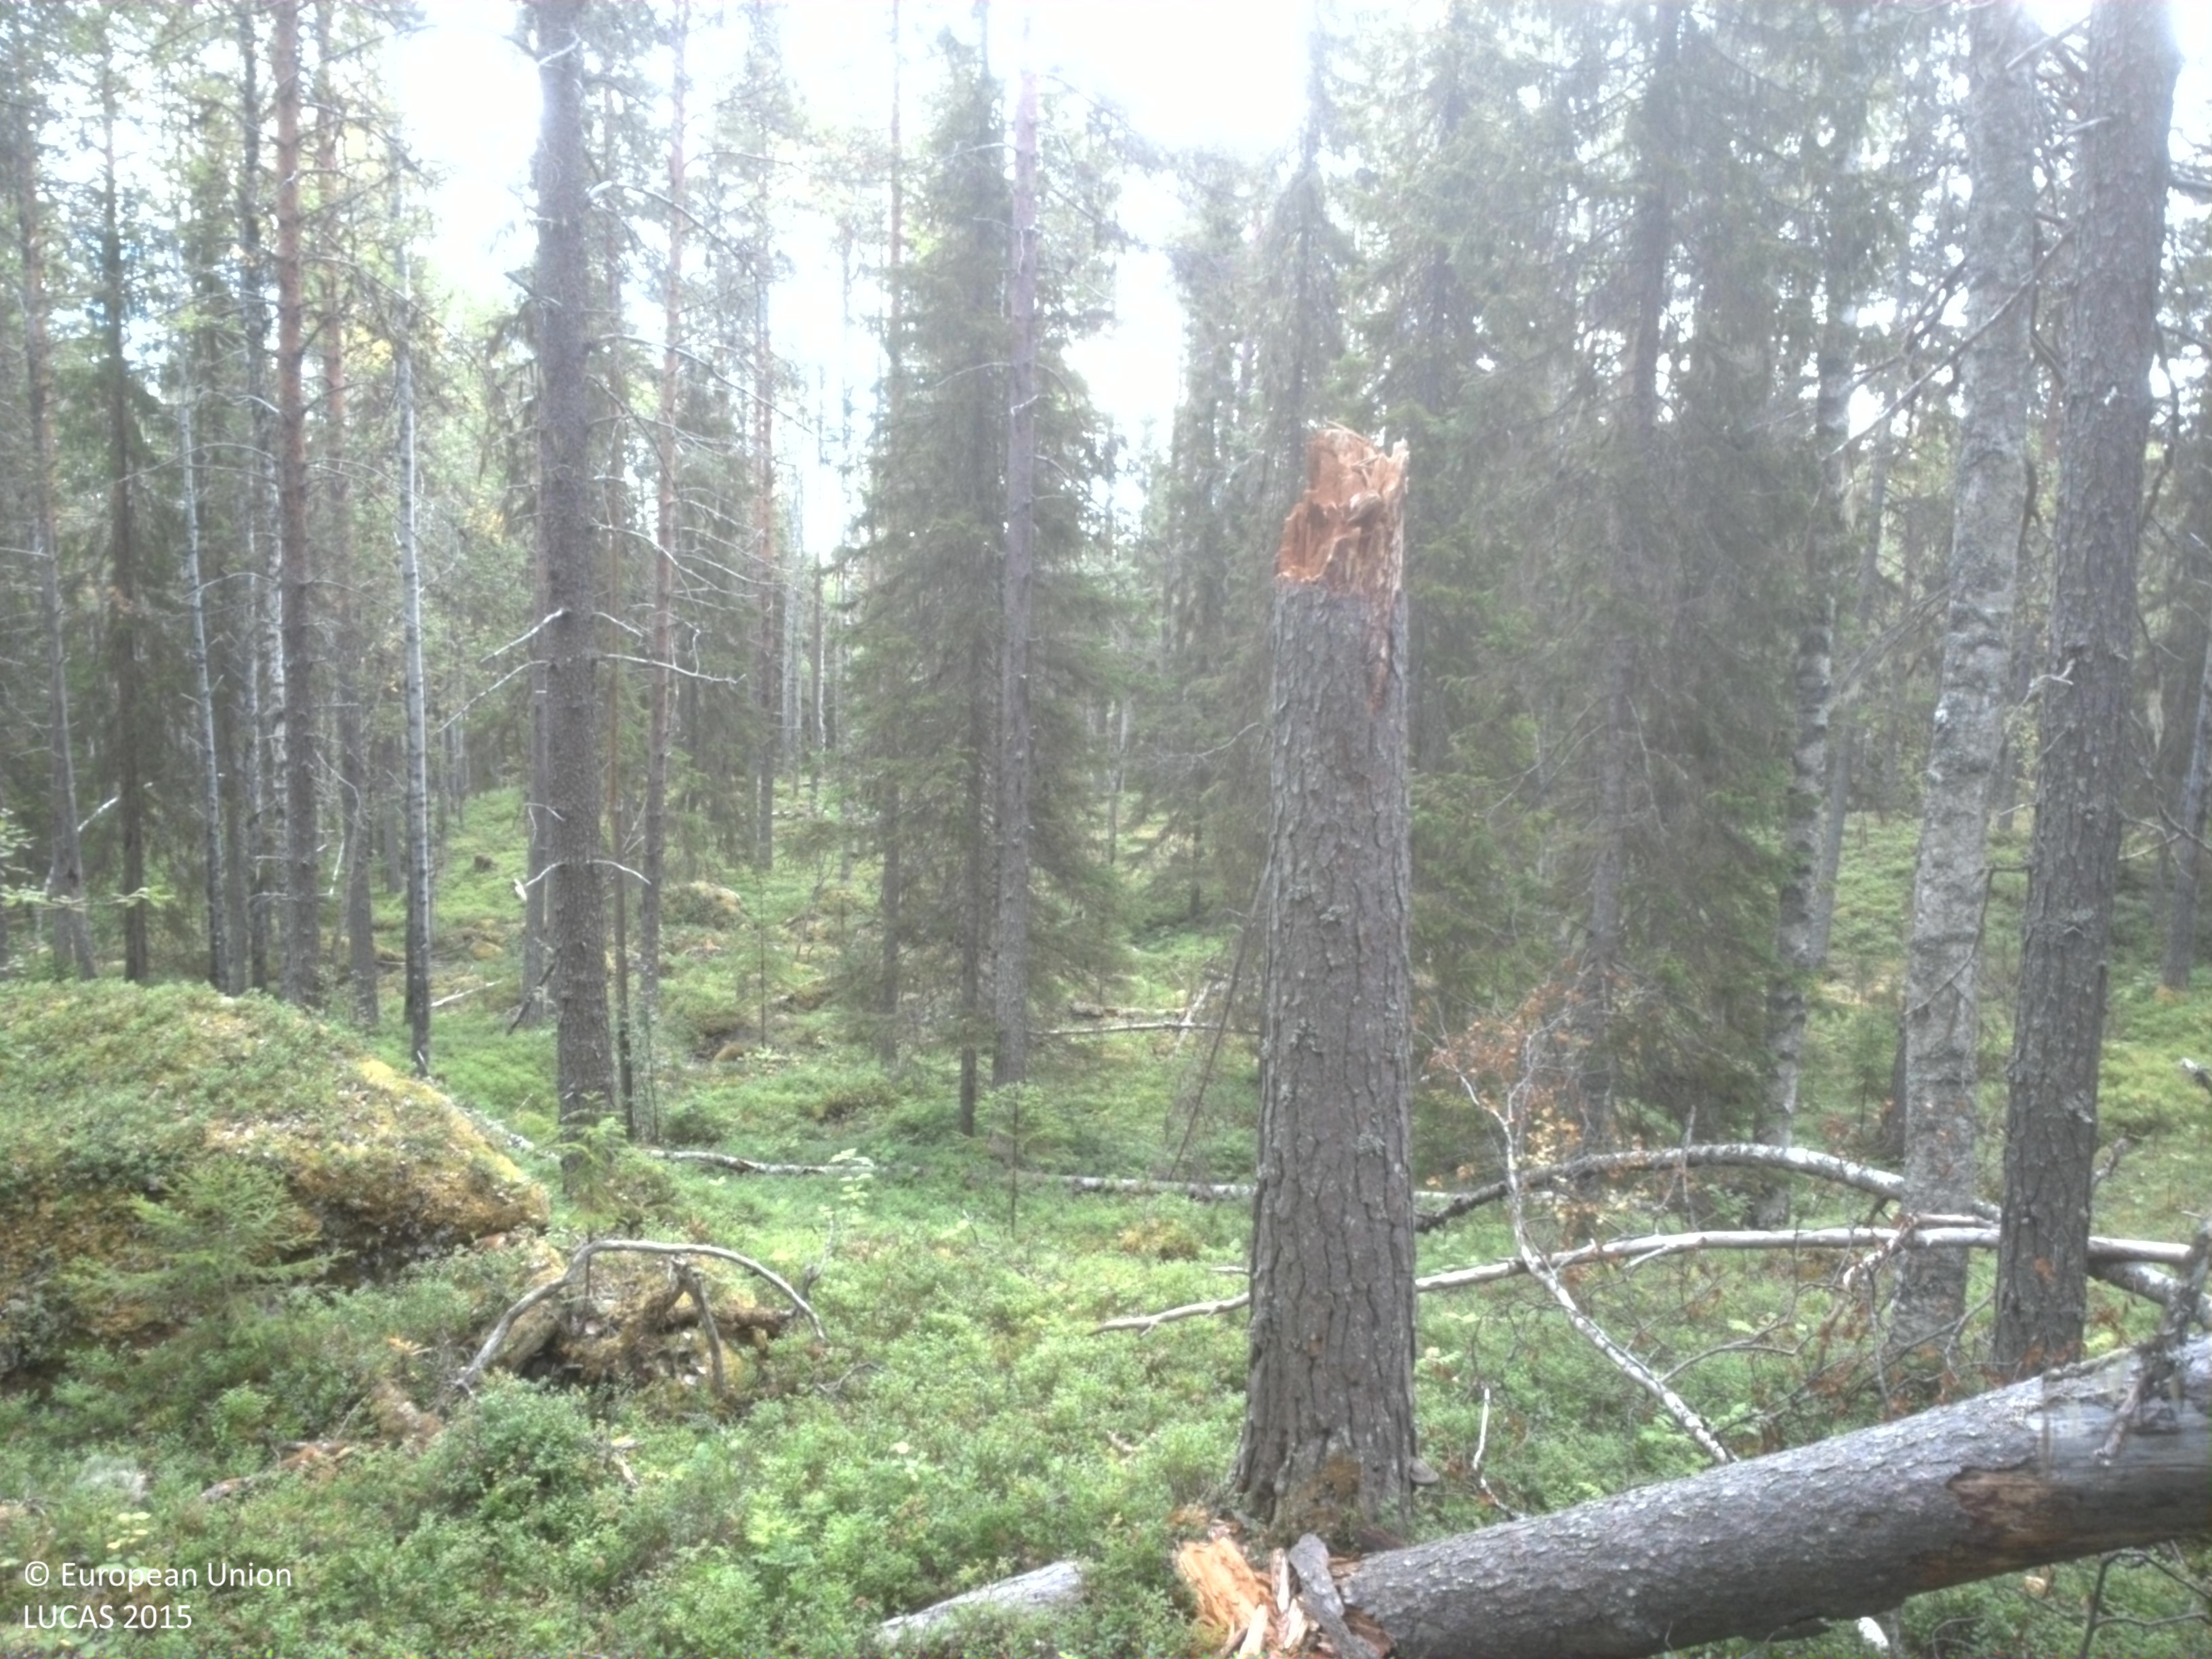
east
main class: Woodland
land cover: Spruce dominated mixed woodland
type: boreal forest
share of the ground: 50 - 75 %
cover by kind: coniferous forest trees 45 %, shrubs 30 %, broadleaved forest trees 15 %, lichens and mosses 10 %
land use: Forestry
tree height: > 5 m
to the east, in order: Spruce dominated mixed woodland; Pine dominated mixed woodland; Pine dominated coniferous woodland; Pine dominated mixed woodland; Other mixed woodland; Ditches and canals; Grass margins; Paved roads, cycling and walking lanes; Grass margins; Spruce dominated mixed woodland; Rivers and streams; Spruce dominated mixed woodland; Spruce dominated coniferous woodland
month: September
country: SE
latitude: 64.6064
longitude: 19.7739
